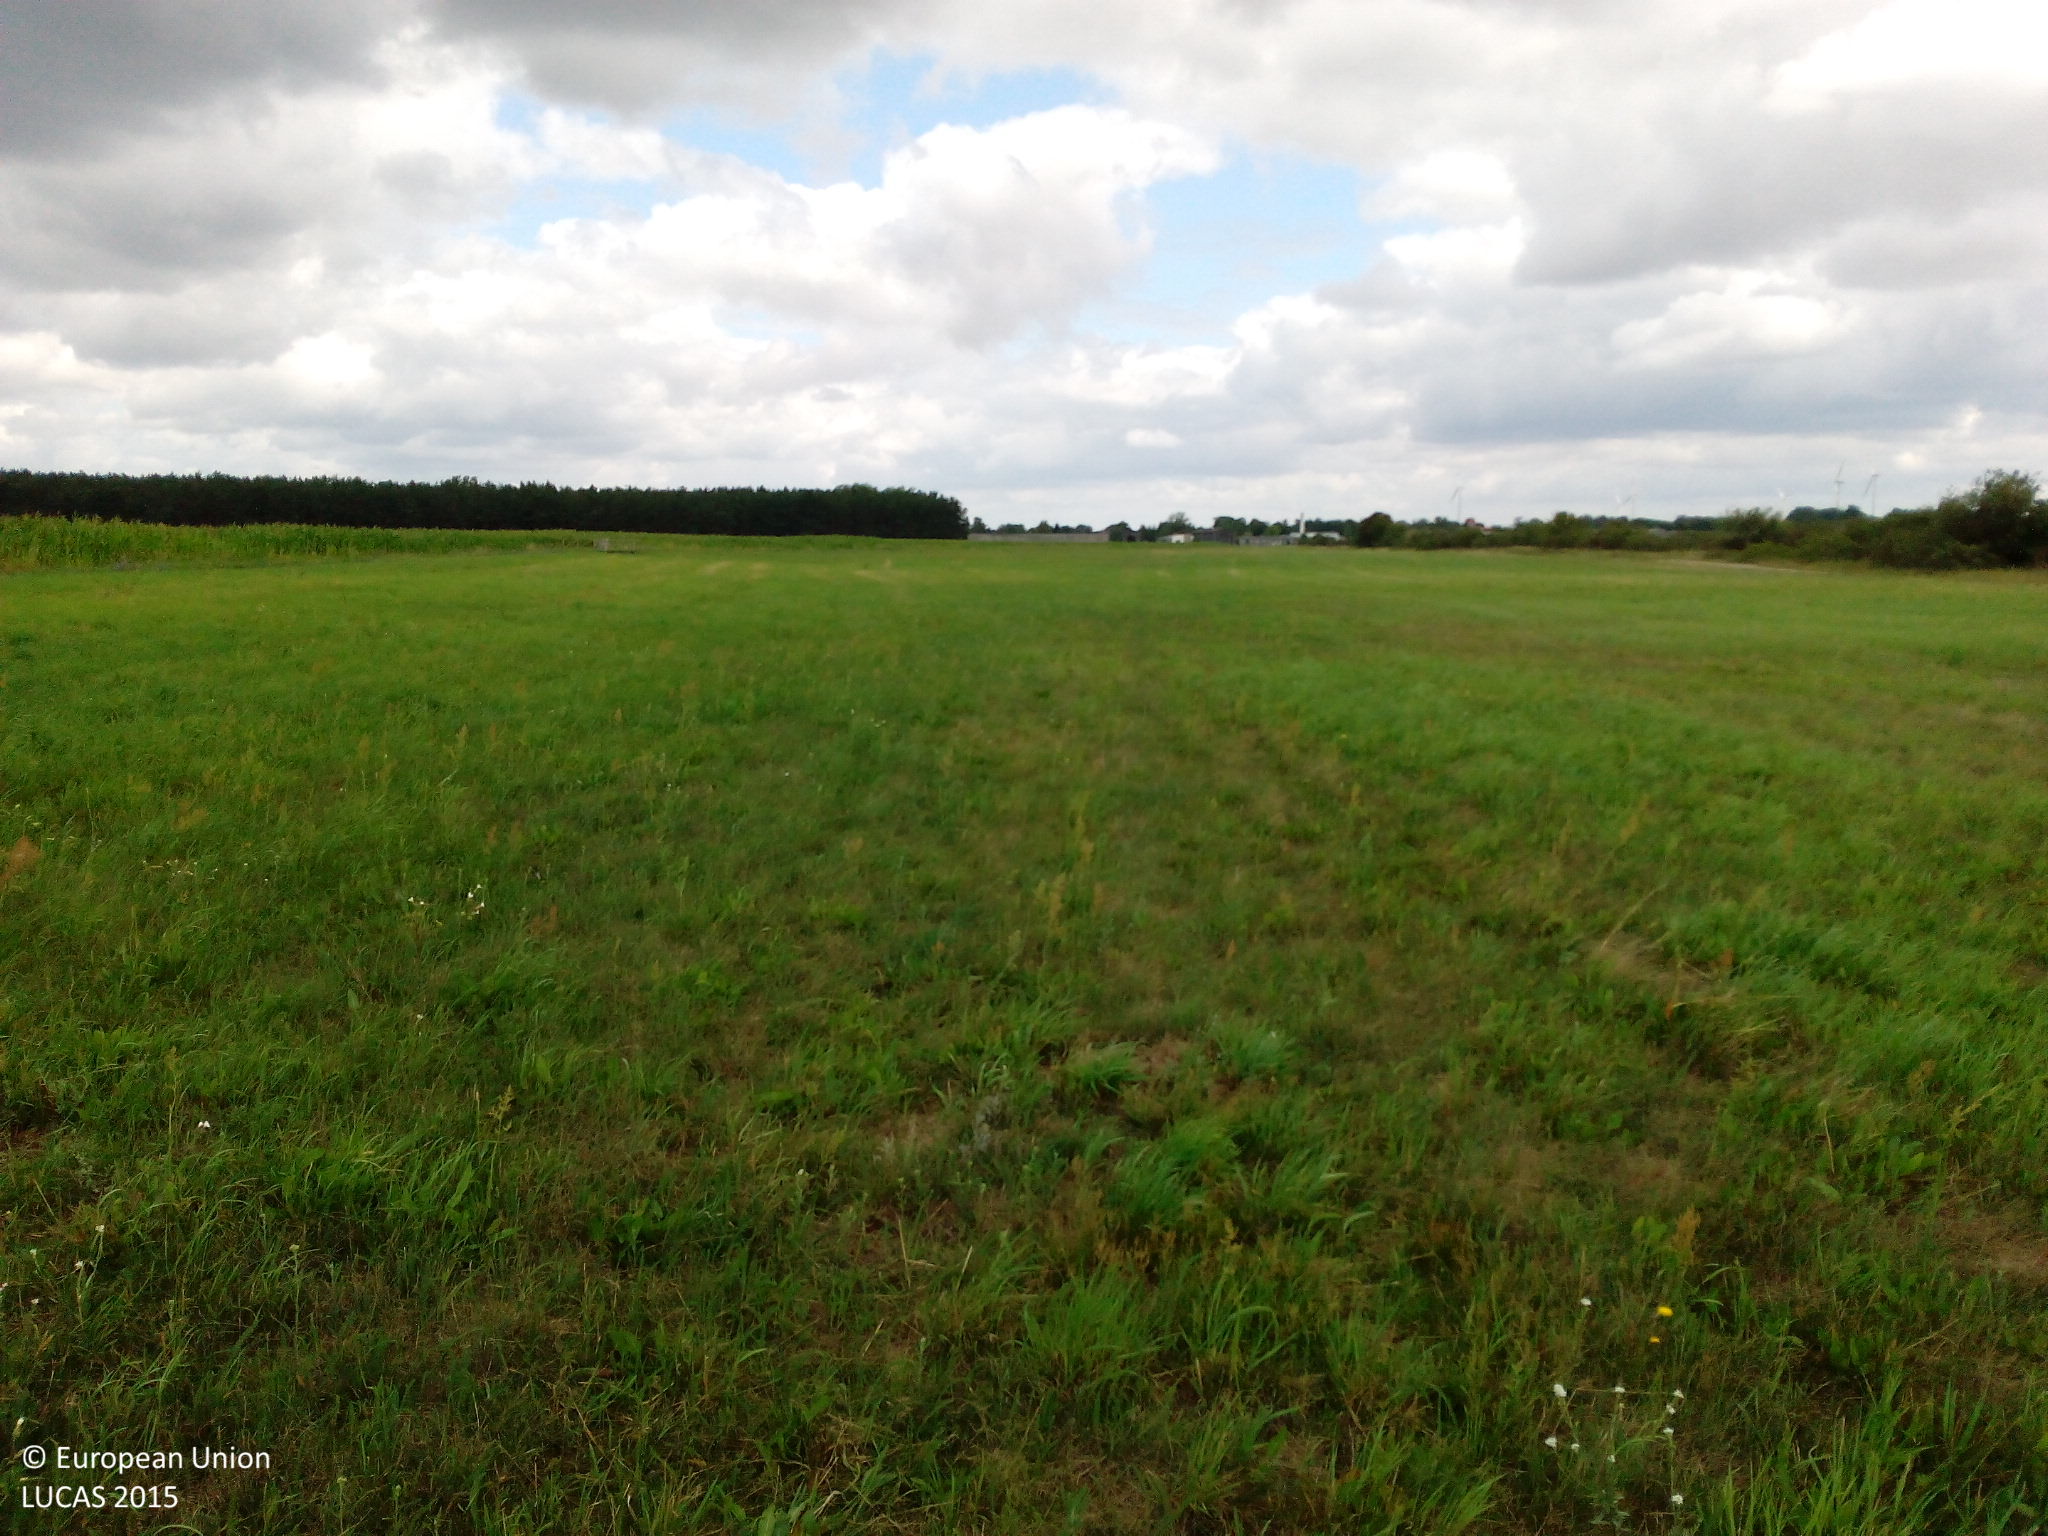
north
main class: Grassland
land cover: Grassland without tree/shrub cover
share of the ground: > 75 %
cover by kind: herbaceous plants 100 %
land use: Agriculture (excluding fallow land and kitchen gardens)
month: July
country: DE
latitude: 52.6827
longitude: 14.1576
